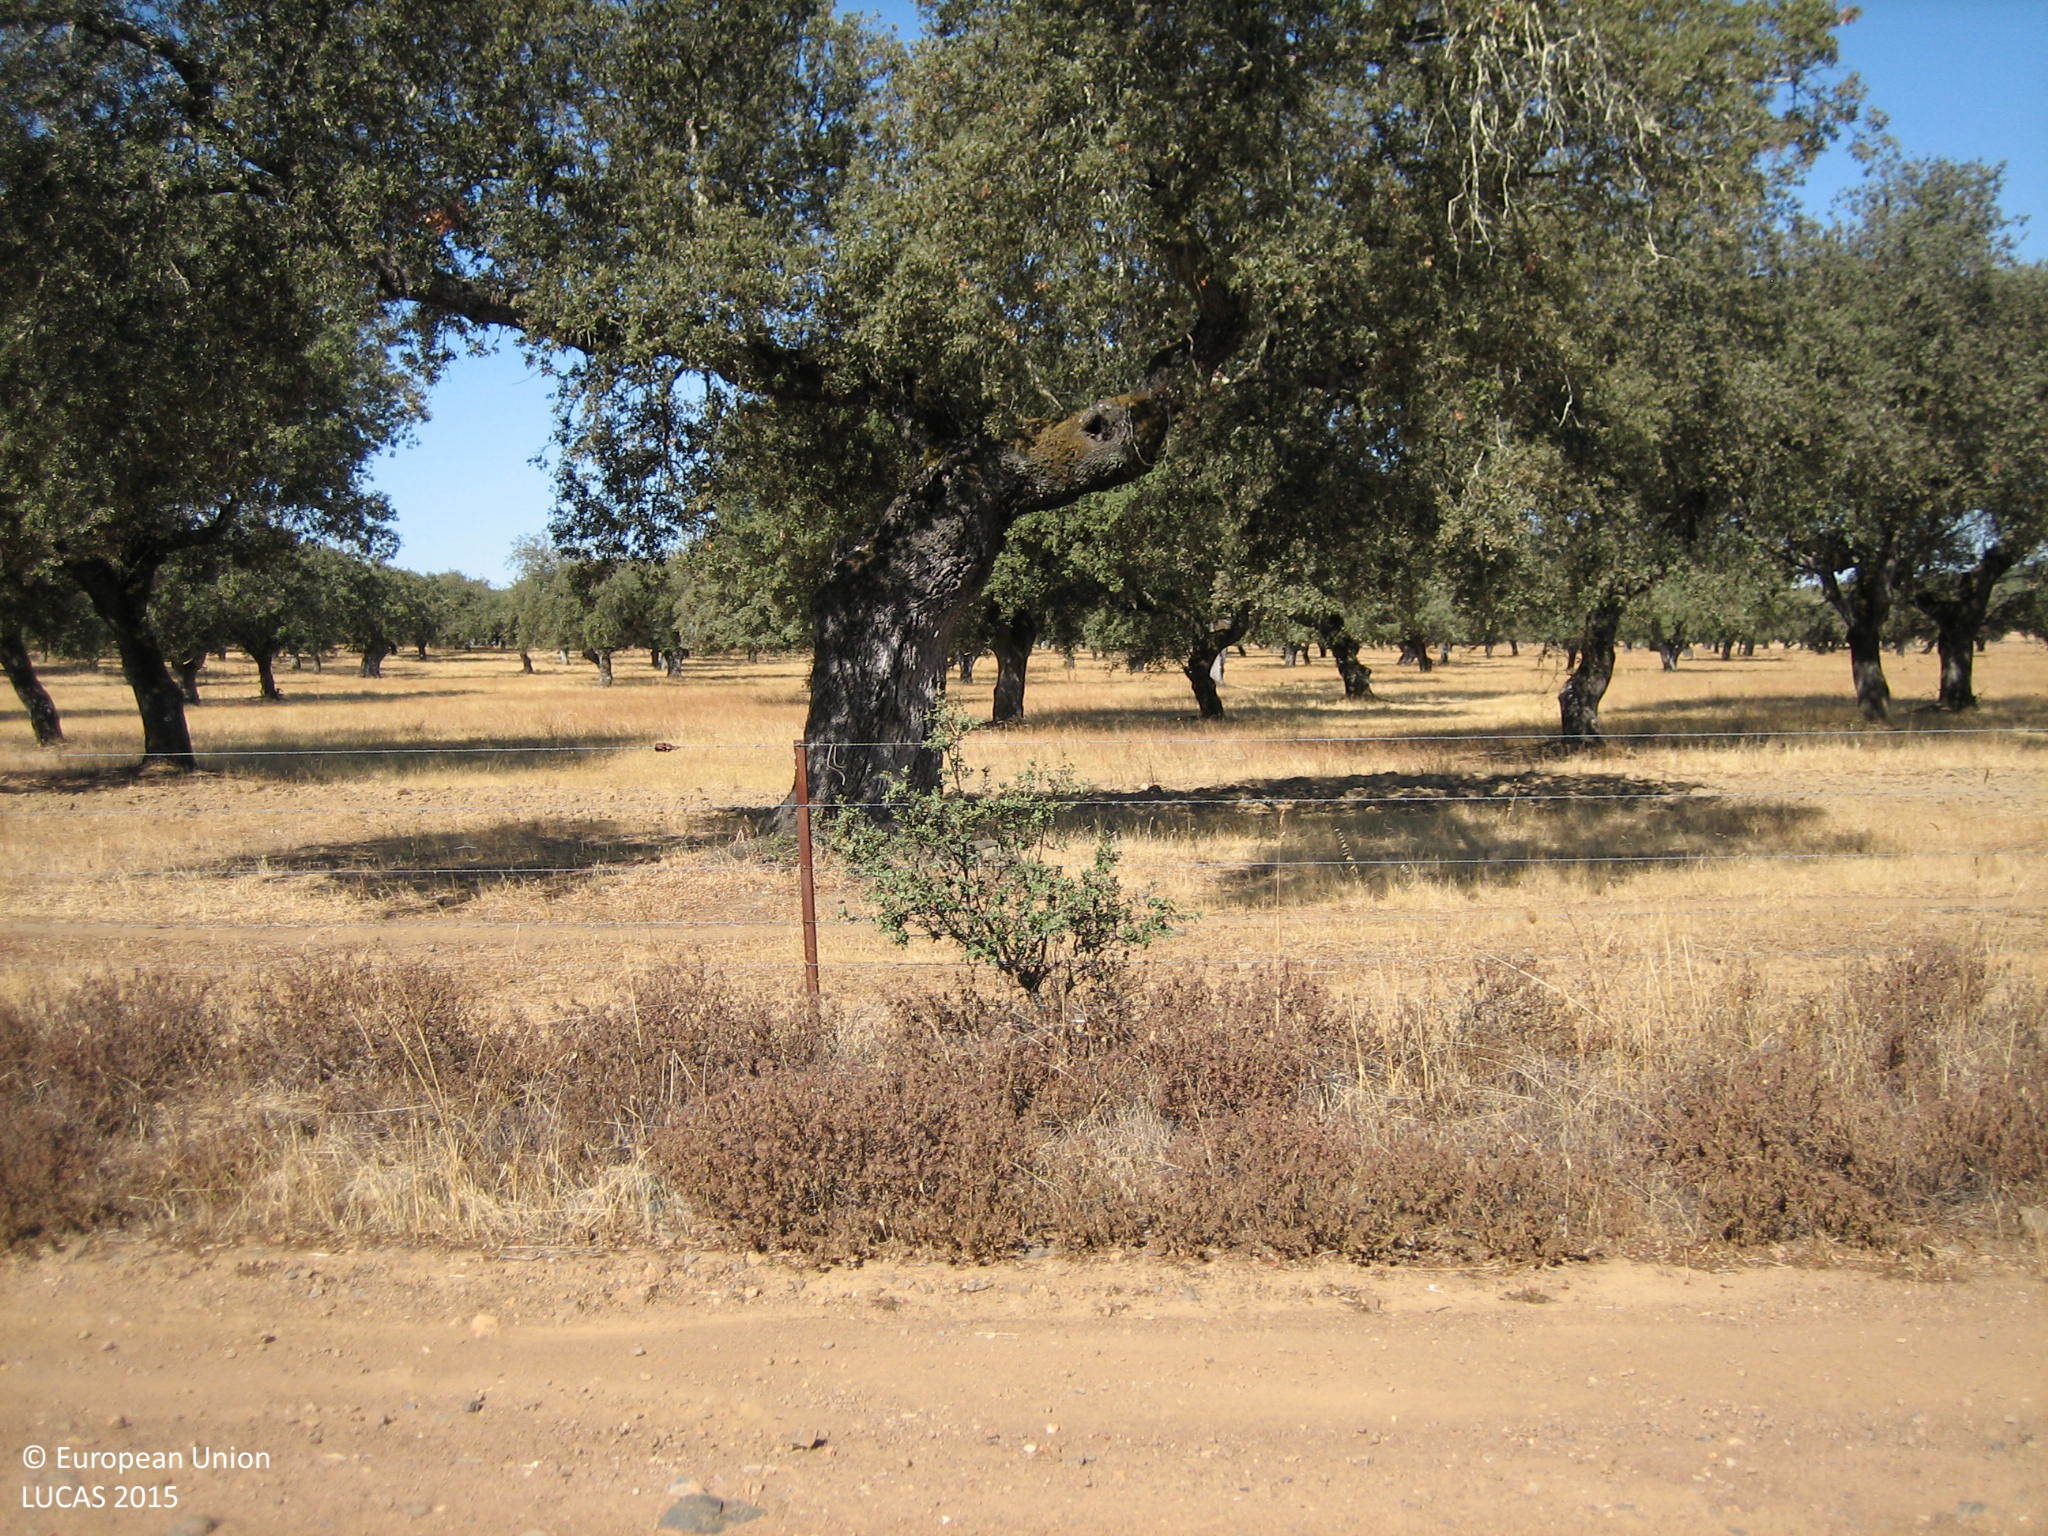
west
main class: Woodland
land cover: Broadleaved woodland
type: broadleaved evergreen forest
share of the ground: 50 - 75 %
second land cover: Grassland without tree/shrub cover
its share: > 75 %
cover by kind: broadleaved forest trees 50 %, herbaceous plants 50 %
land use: Forestry
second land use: Agriculture (excluding fallow land and kitchen gardens)
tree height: > 5 m
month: August
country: ES
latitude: 38.4058
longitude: -7.1856
